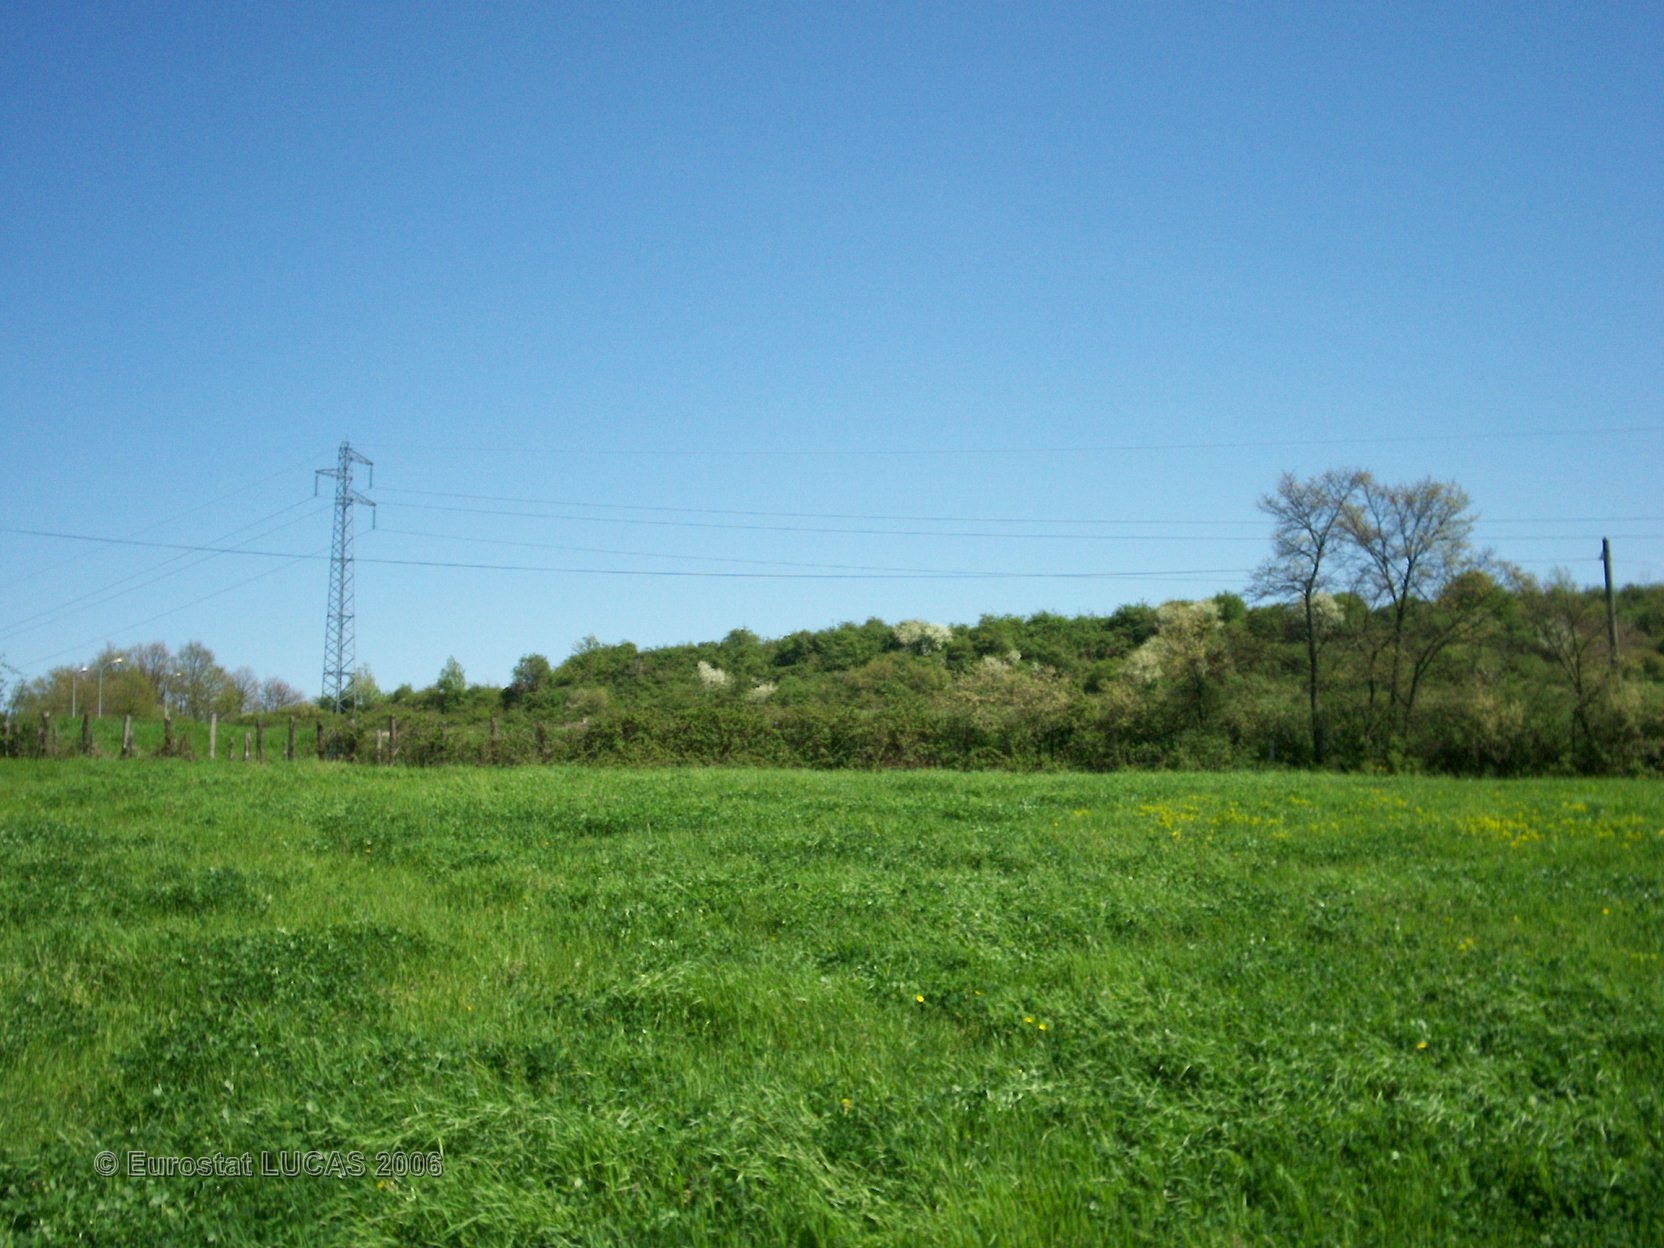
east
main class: Grassland
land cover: Grassland without tree/shrub cover
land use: Agriculture (excluding fallow land and kitchen gardens)
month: April
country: FR
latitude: 45.5936
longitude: 4.8123
